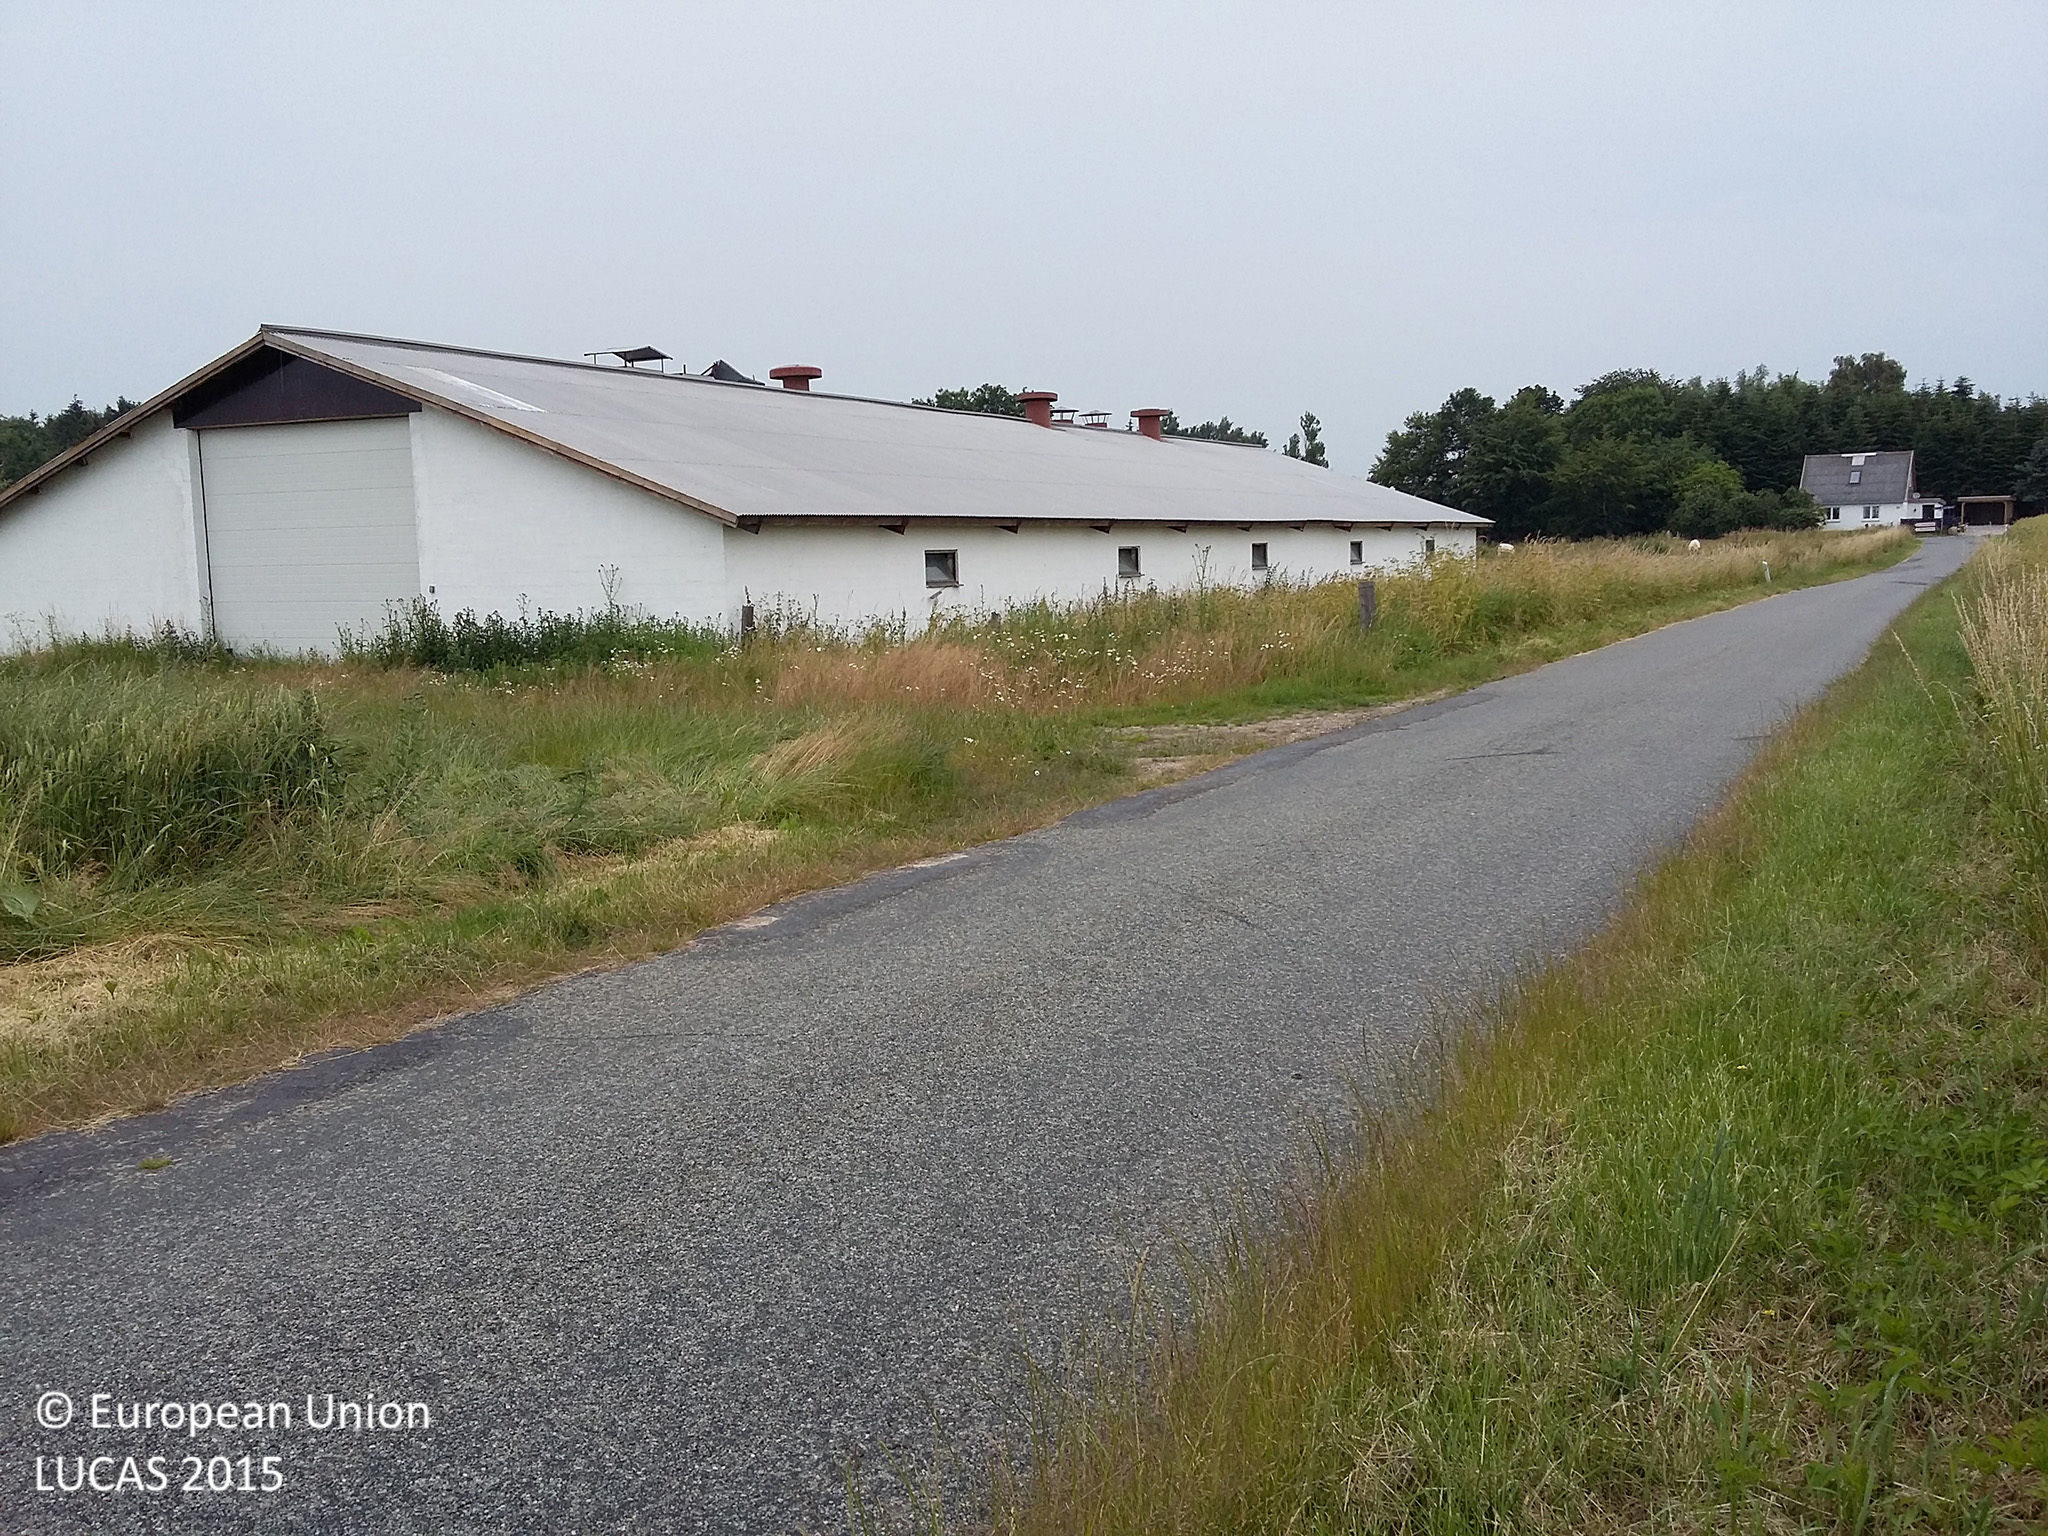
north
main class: Cropland
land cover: Rape and turnip rape
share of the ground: > 75 %
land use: Agriculture (excluding fallow land and kitchen gardens)
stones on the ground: < 10 %
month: July
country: DK
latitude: 55.2782
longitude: 11.6516
